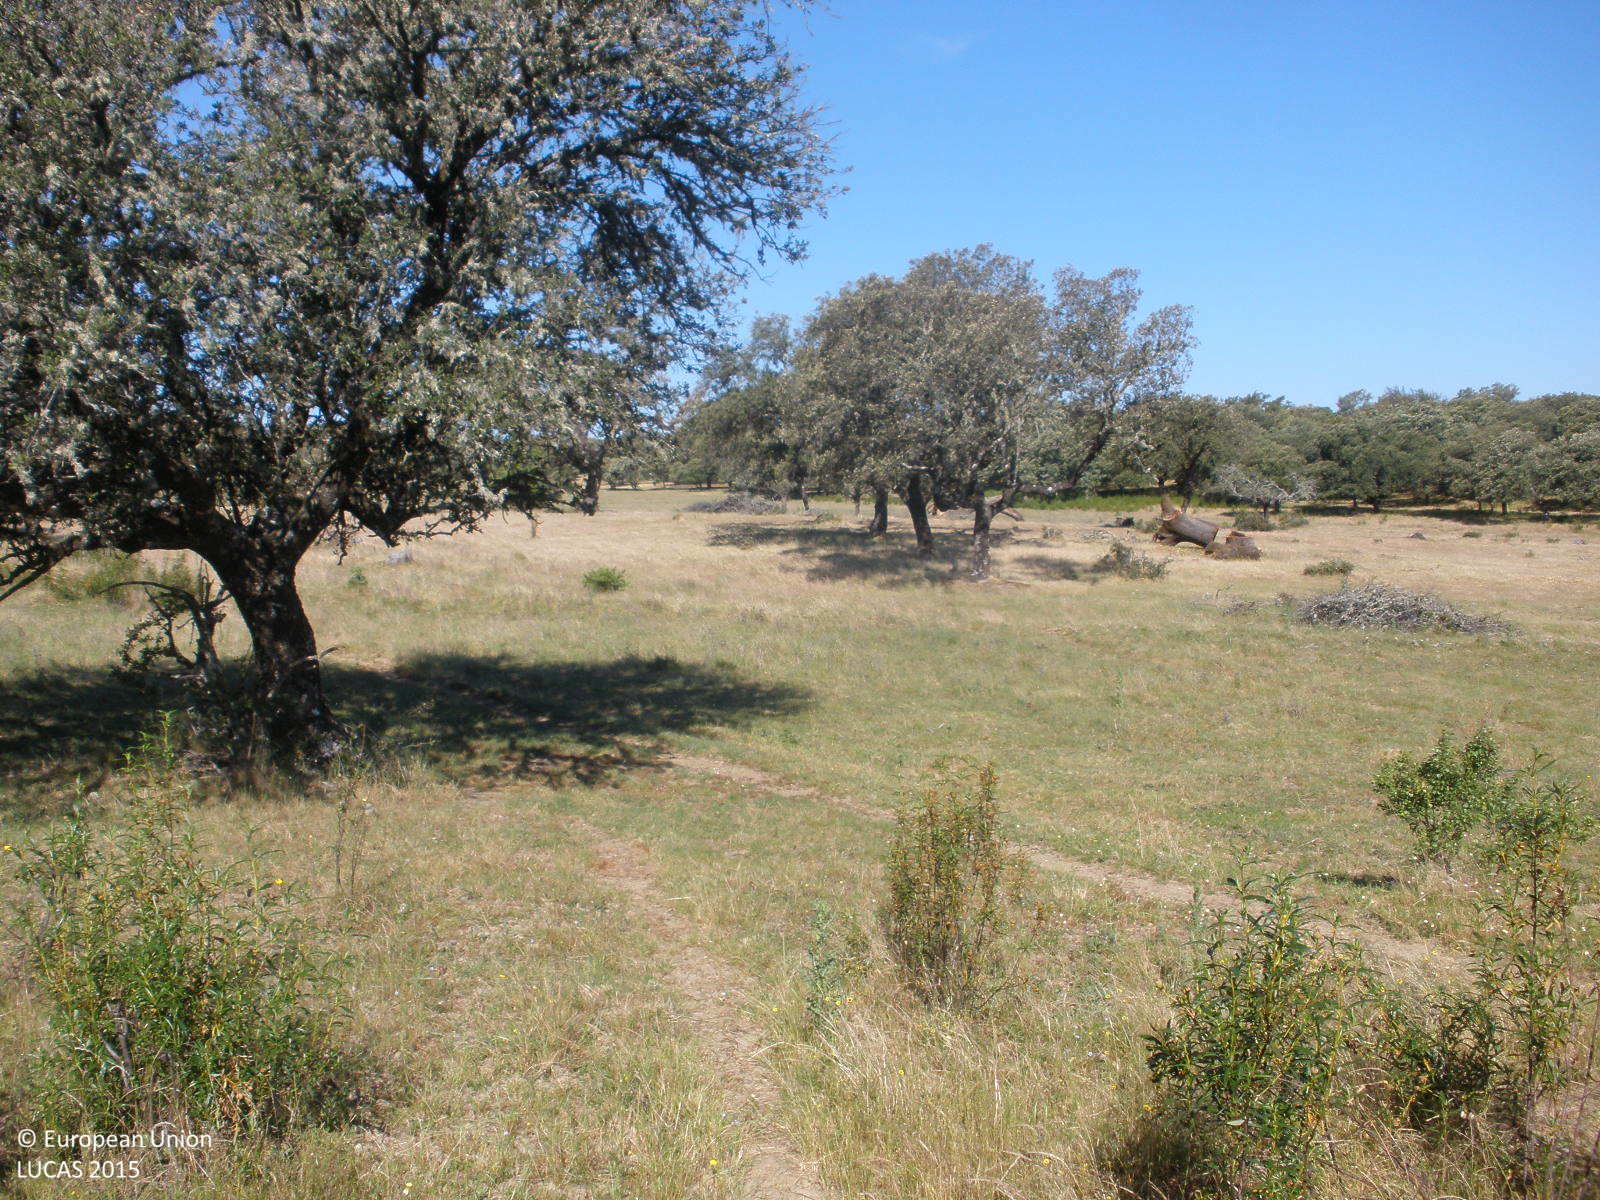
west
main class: Woodland
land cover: Broadleaved woodland
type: broadleaved evergreen forest
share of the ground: 50 - 75 %
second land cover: Grassland without tree/shrub cover
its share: > 75 %
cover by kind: herbaceous plants 60 %, broadleaved forest trees 35 %, shrubs 5 %
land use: Forestry
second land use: Agriculture (excluding fallow land and kitchen gardens)
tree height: < 5 m
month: May
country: ES
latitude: 40.2260
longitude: -6.2607
